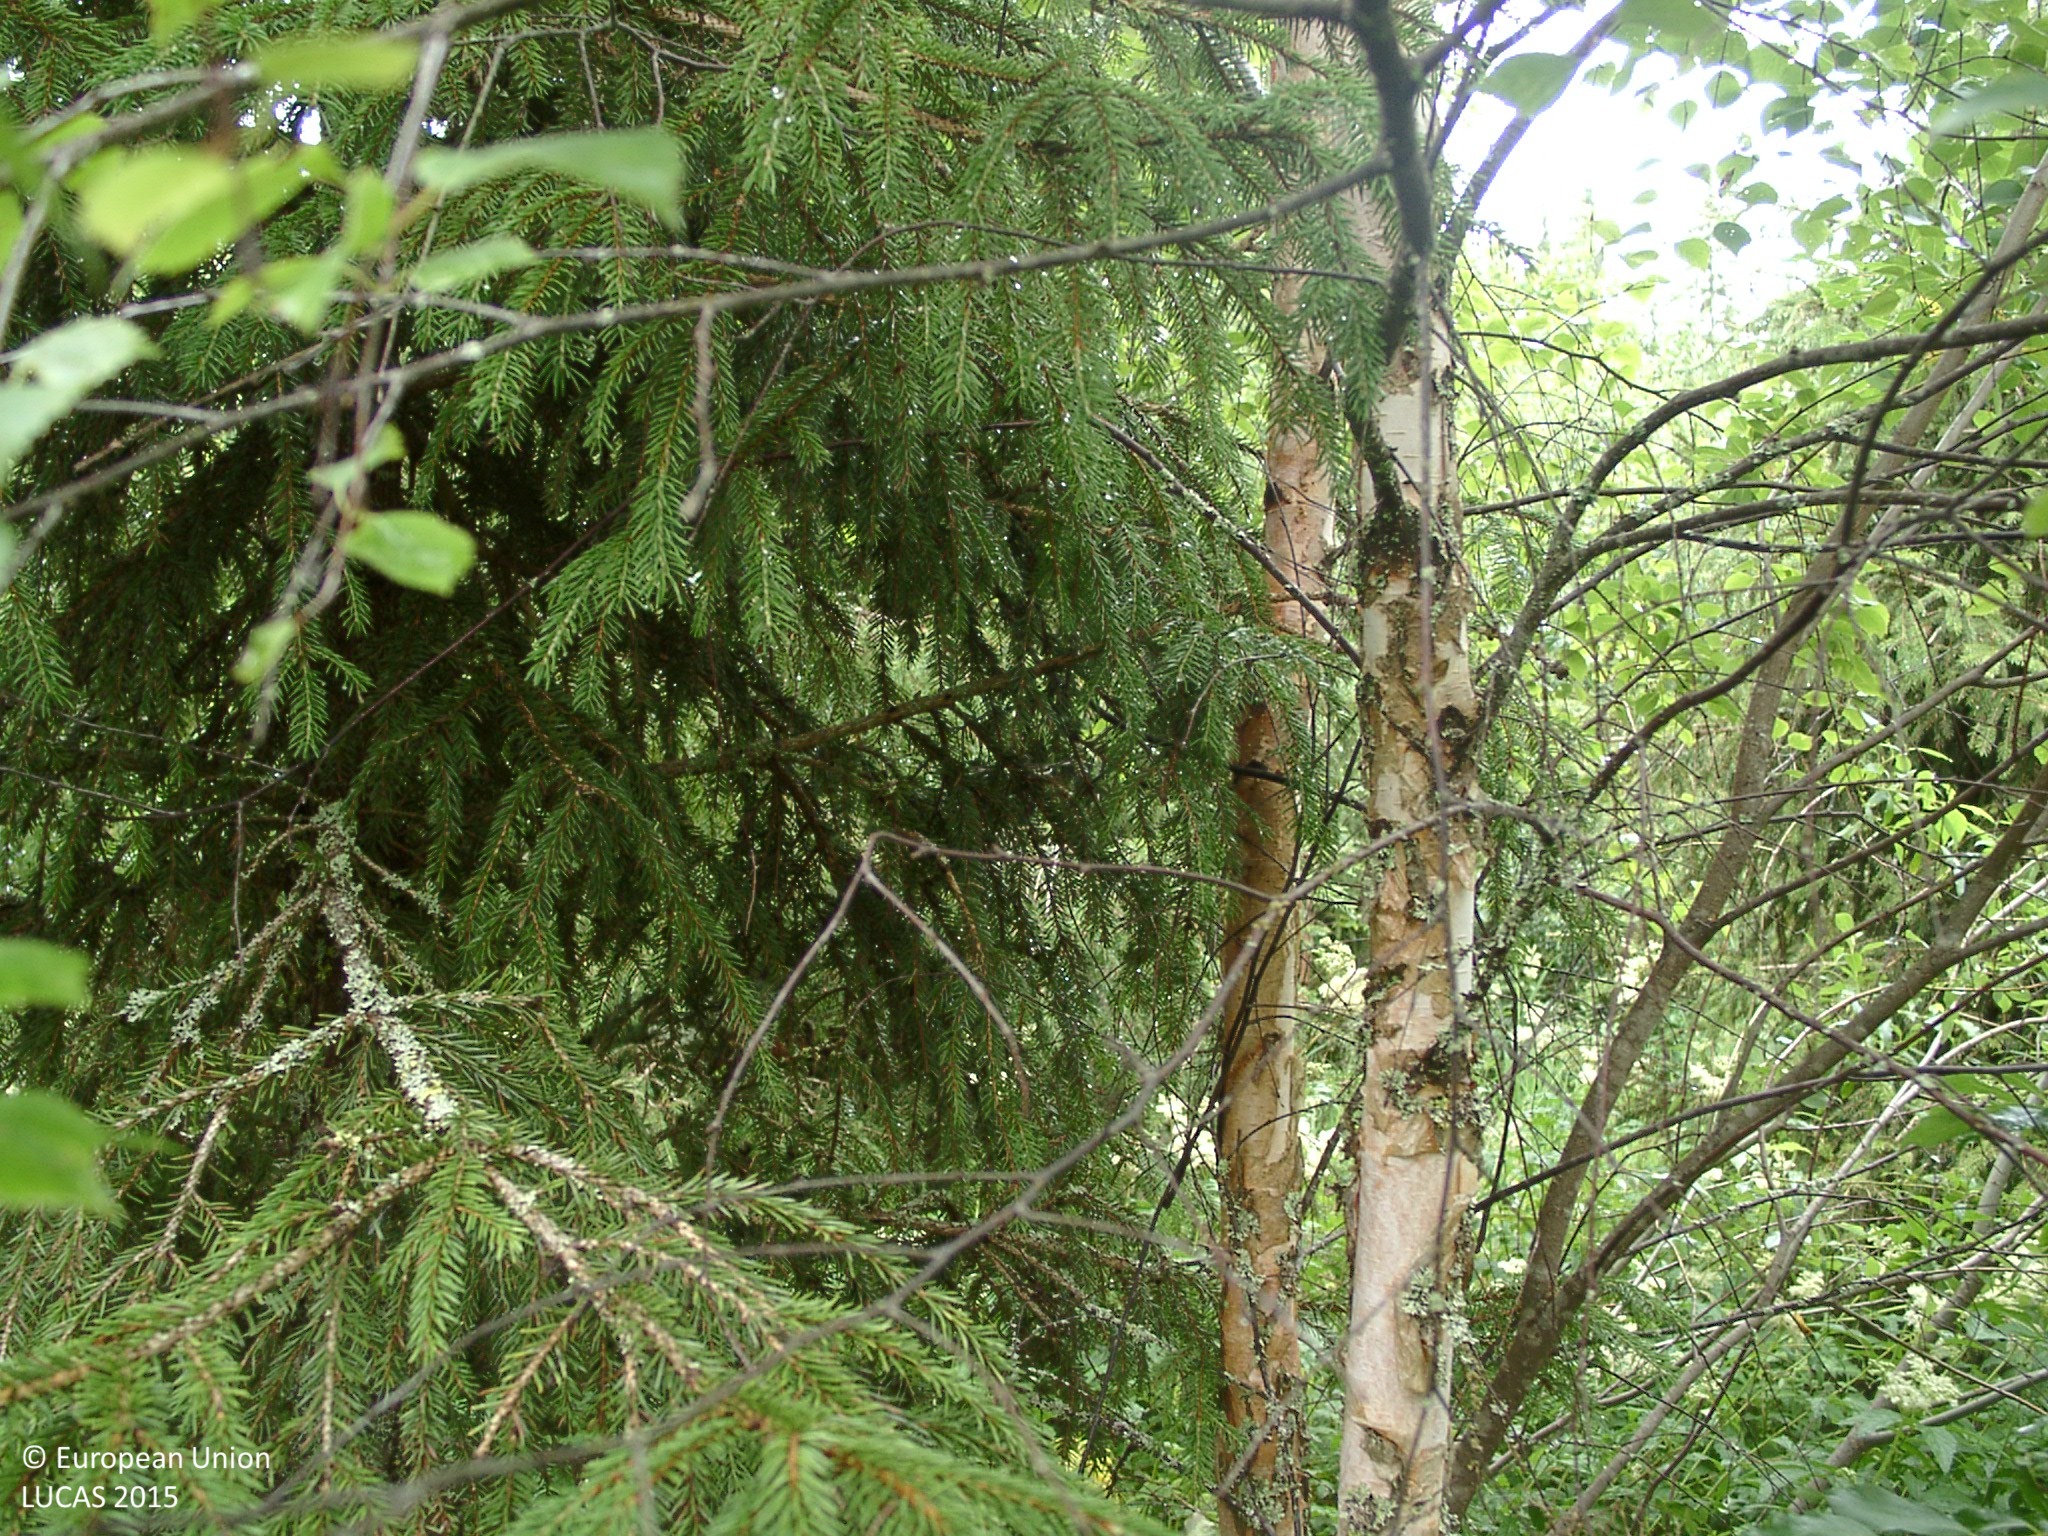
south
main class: Woodland
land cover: Spruce dominated mixed woodland
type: boreal forest
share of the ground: 50 - 75 %
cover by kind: coniferous forest trees 30 %, broadleaved forest trees 25 %, herbaceous plants 25 %, shrubs 20 %
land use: Forestry
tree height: < 5 m
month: July
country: FI
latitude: 62.2495
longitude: 25.4565
